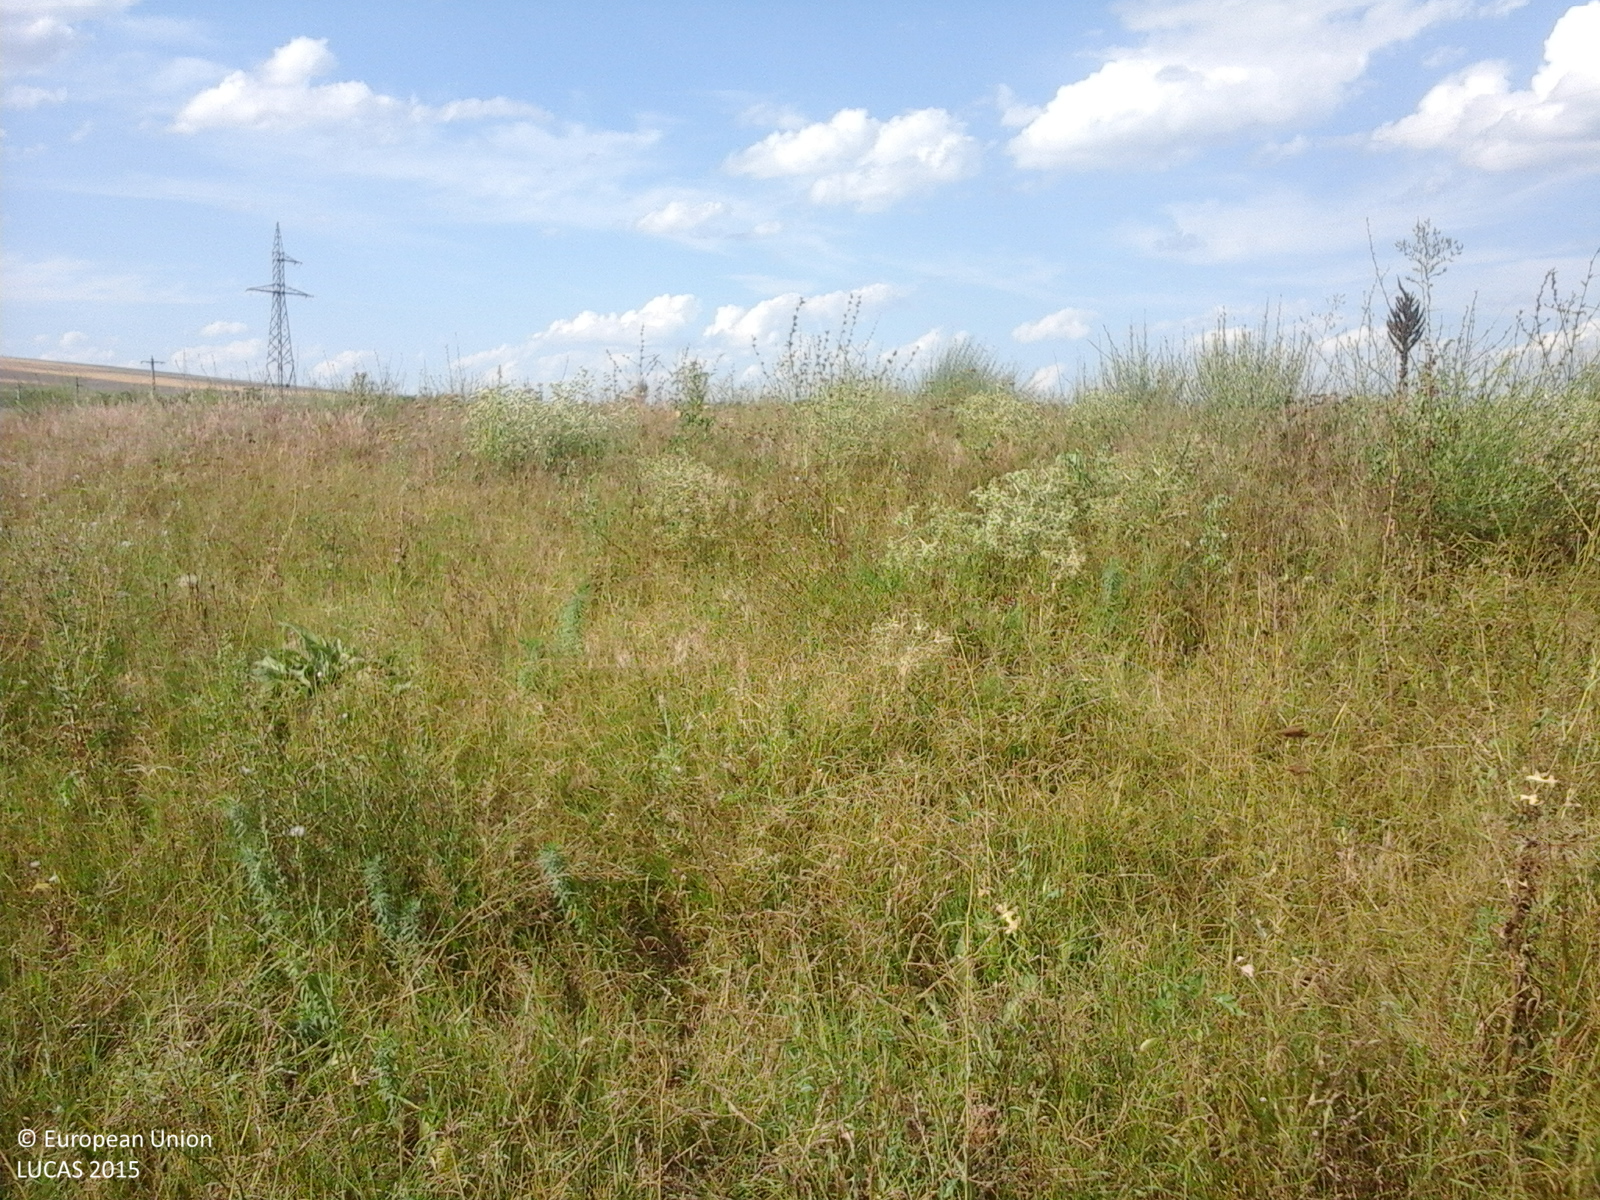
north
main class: Grassland
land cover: Grassland without tree/shrub cover
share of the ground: > 75 %
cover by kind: herbaceous plants 100 %
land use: Agriculture (excluding fallow land and kitchen gardens)
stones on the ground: < 10 %
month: July
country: RO
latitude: 46.3396
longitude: 27.7742
